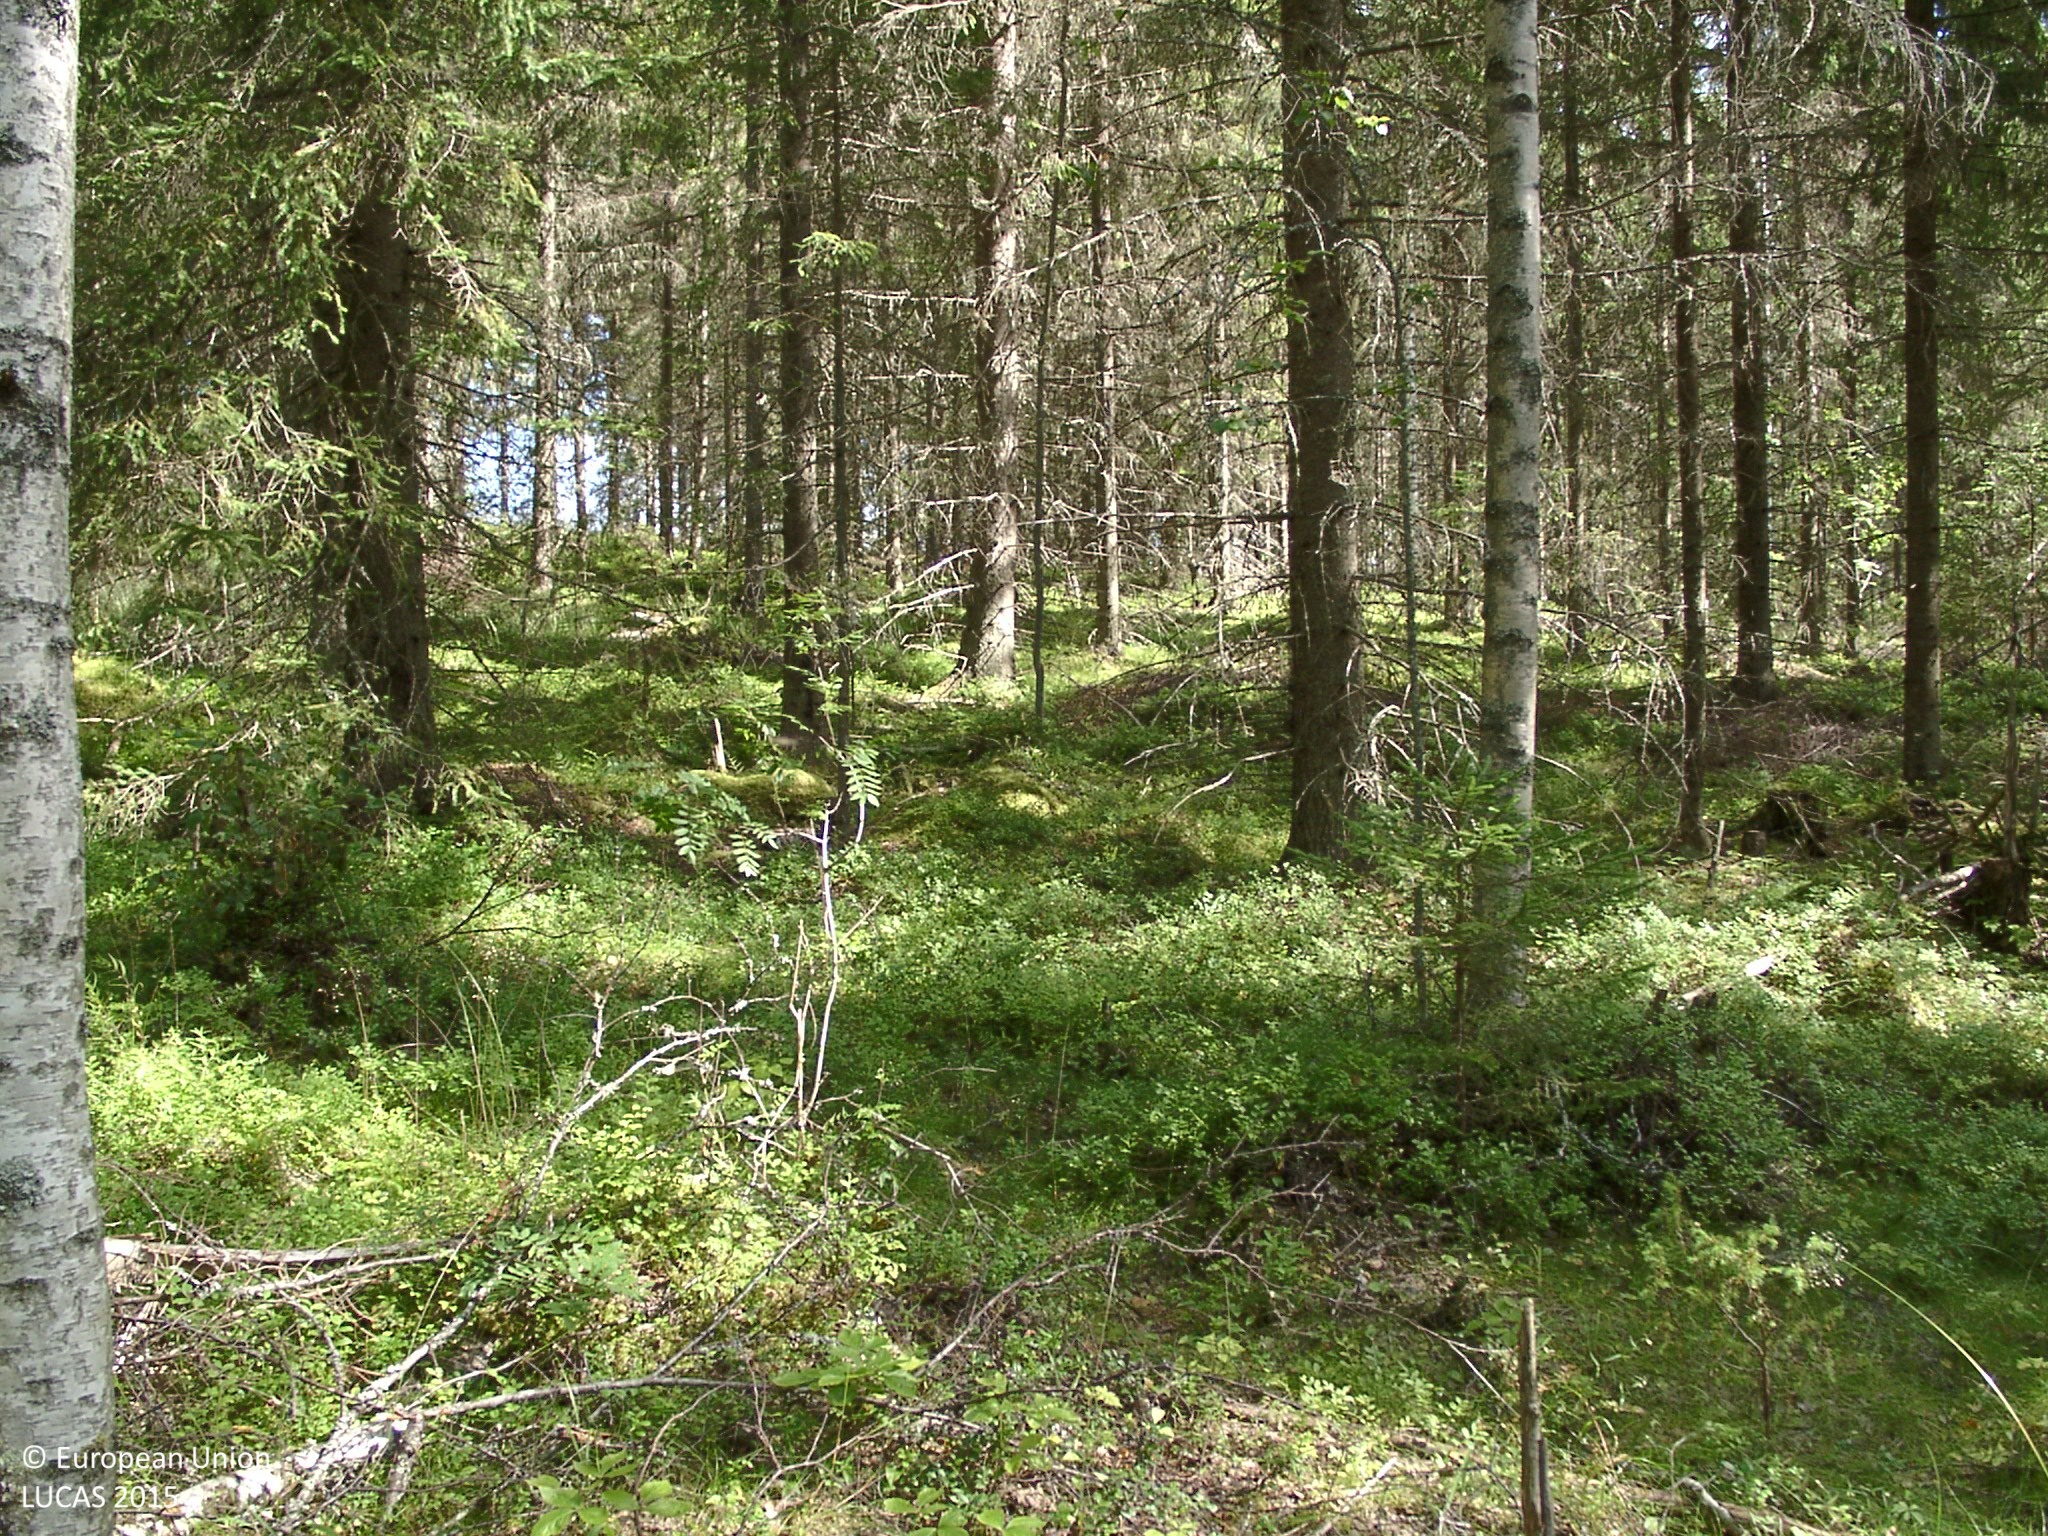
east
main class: Woodland
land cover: Spruce dominated mixed woodland
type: boreal forest
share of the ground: 50 - 75 %
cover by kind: coniferous forest trees 50 %, broadleaved forest trees 20 %, shrubs 15 %, lichens and mosses 10 %, herbaceous plants 5 %
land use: Forestry
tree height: > 5 m
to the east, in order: Spruce dominated mixed woodland; Grass margins; Spruce dominated coniferous woodland; Grass margins; Spruce dominated coniferous woodland; Grassland without tree/shrub cover; Grassland with sparse tree/shrub cover; Other leguminous and mixtures for fodder
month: August
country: FI
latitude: 62.9367
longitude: 25.0502
